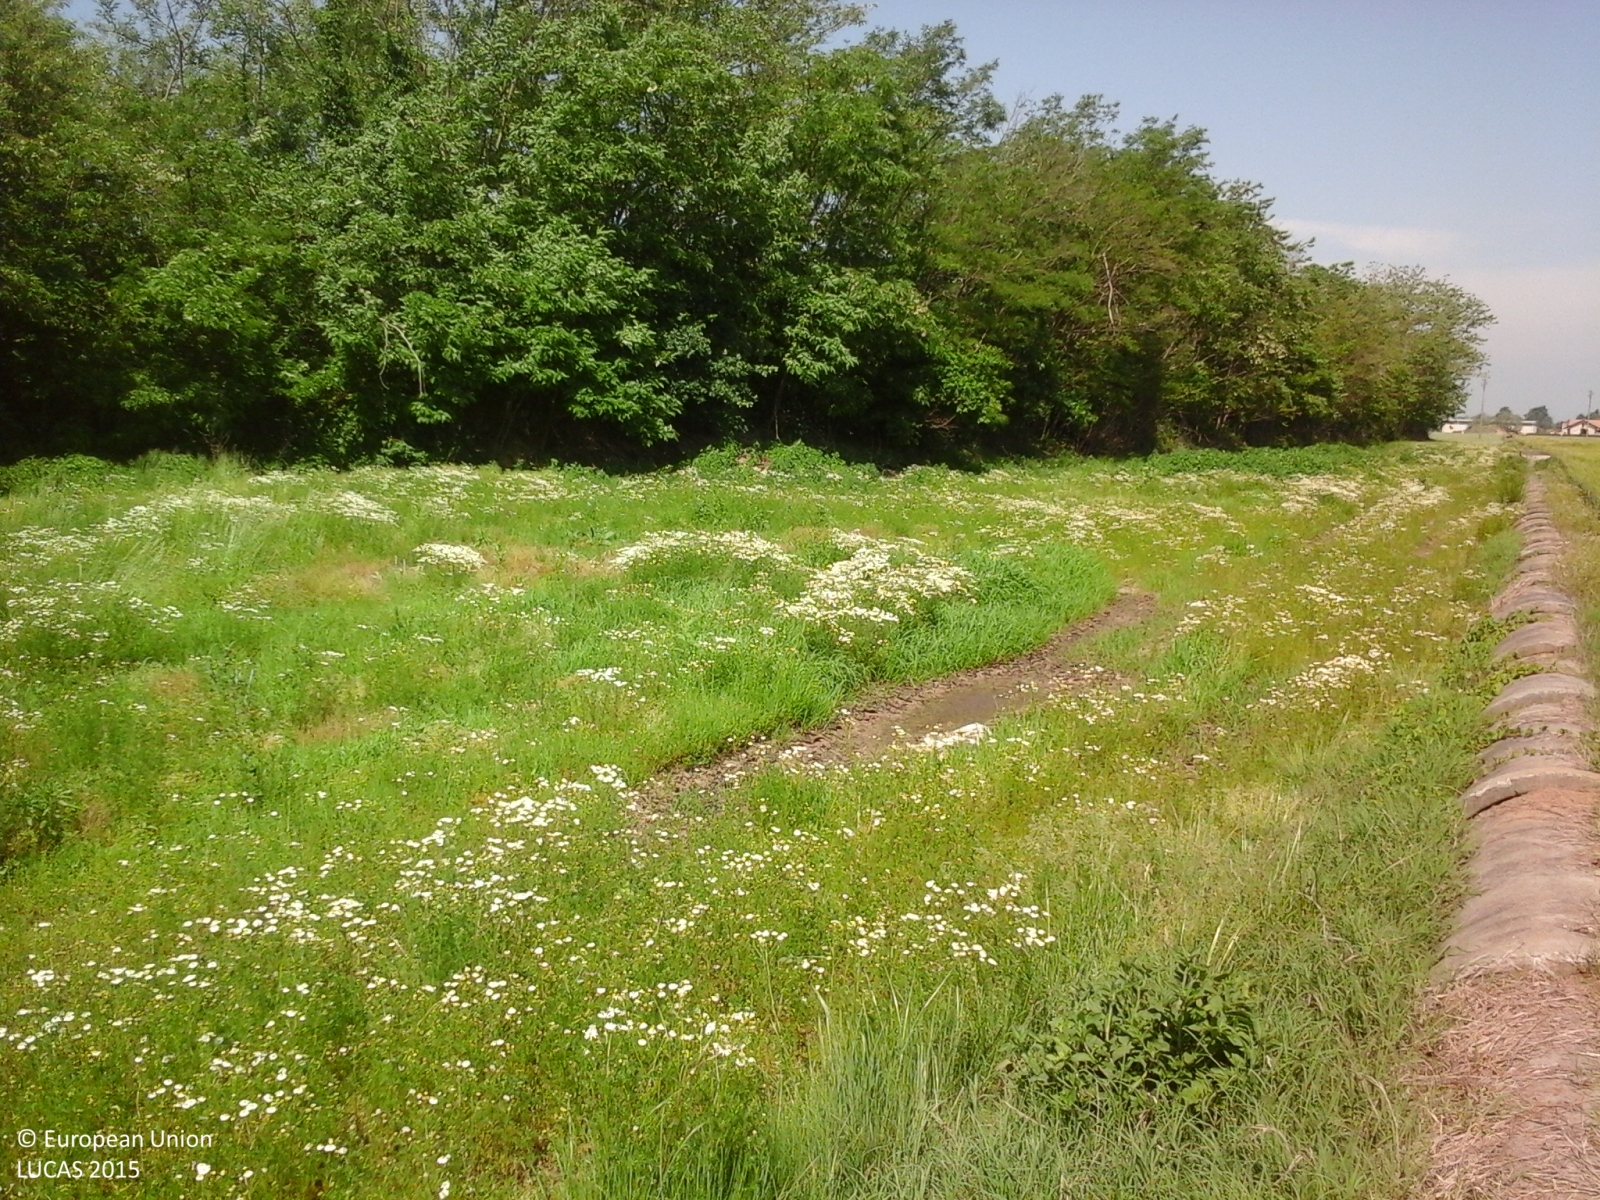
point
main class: Grassland
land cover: Grassland without tree/shrub cover
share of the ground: > 75 %
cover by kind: herbaceous plants 100 %
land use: Agriculture (excluding fallow land and kitchen gardens)
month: May
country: IT
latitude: 45.5670
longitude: 8.5801
